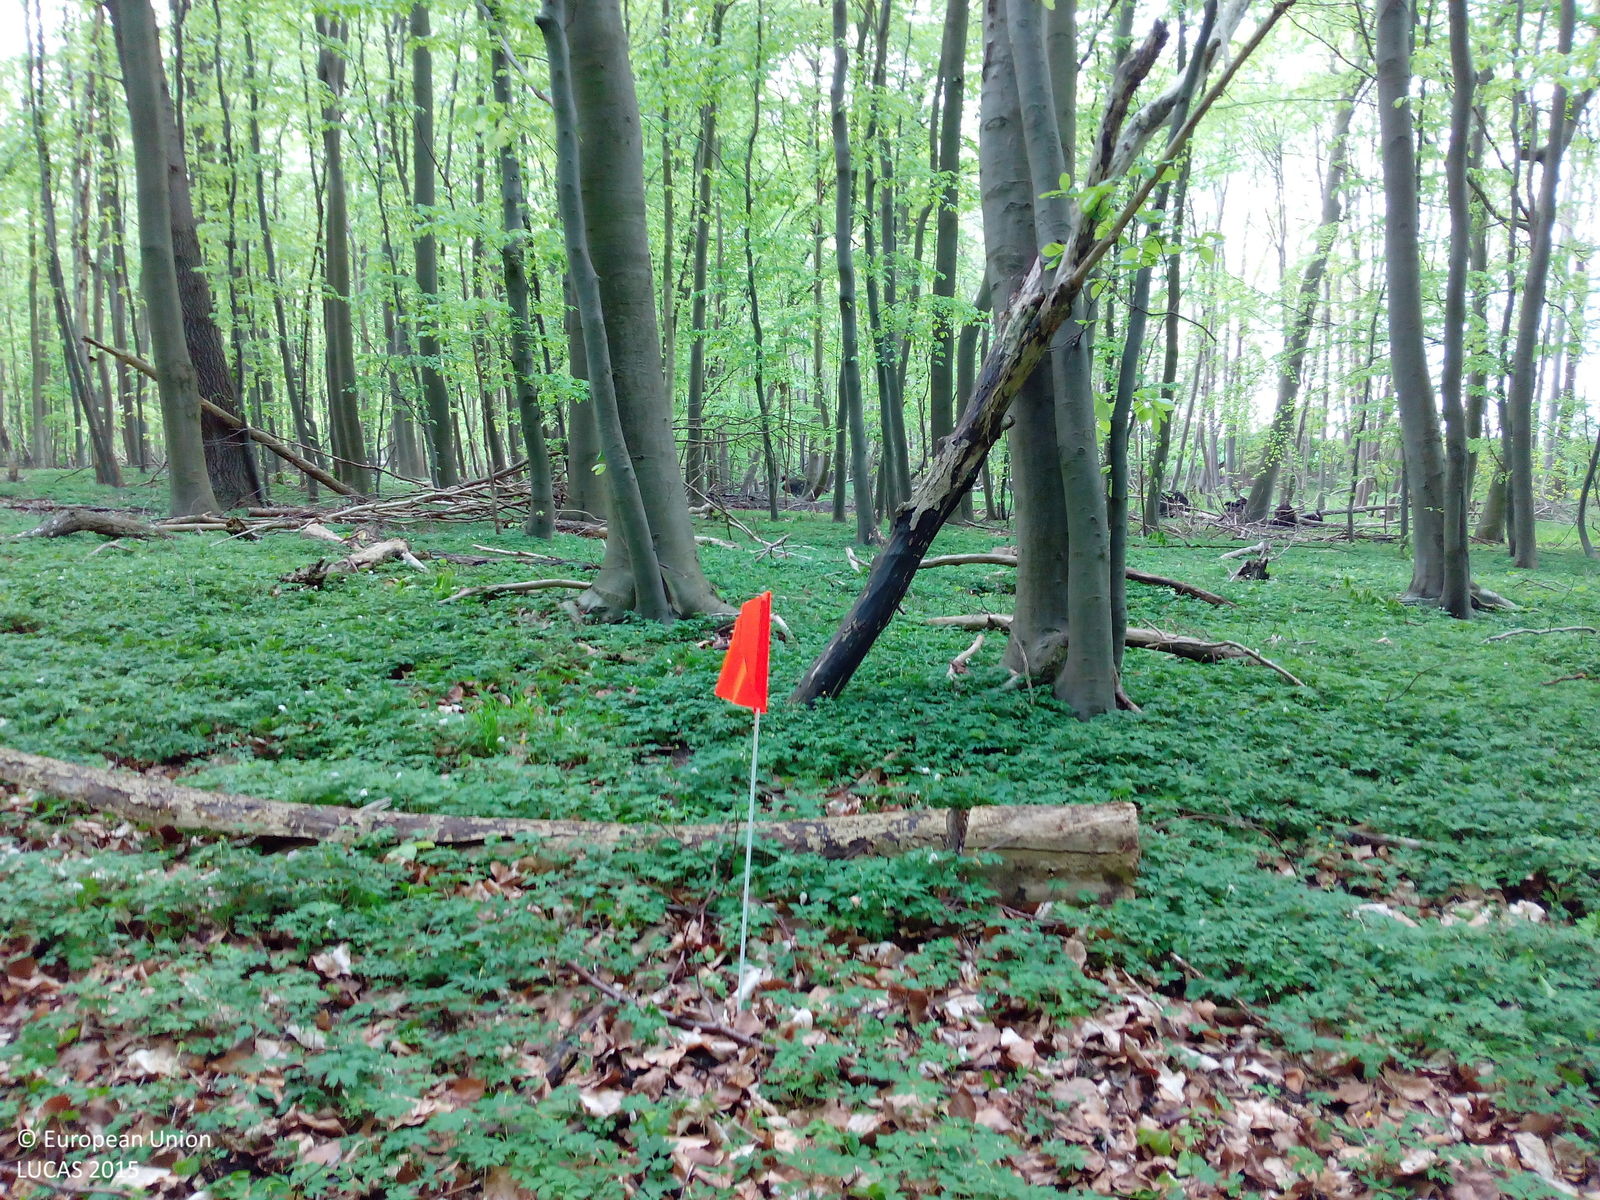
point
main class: Woodland
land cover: Broadleaved woodland
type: beech forest
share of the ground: 50 - 75 %
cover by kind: broadleaved forest trees 70 %, unconsolidated bare surface 25 %, herbaceous plants 5 %
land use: Forestry
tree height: > 5 m
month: May
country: DE
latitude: 53.4071
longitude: 11.7593
